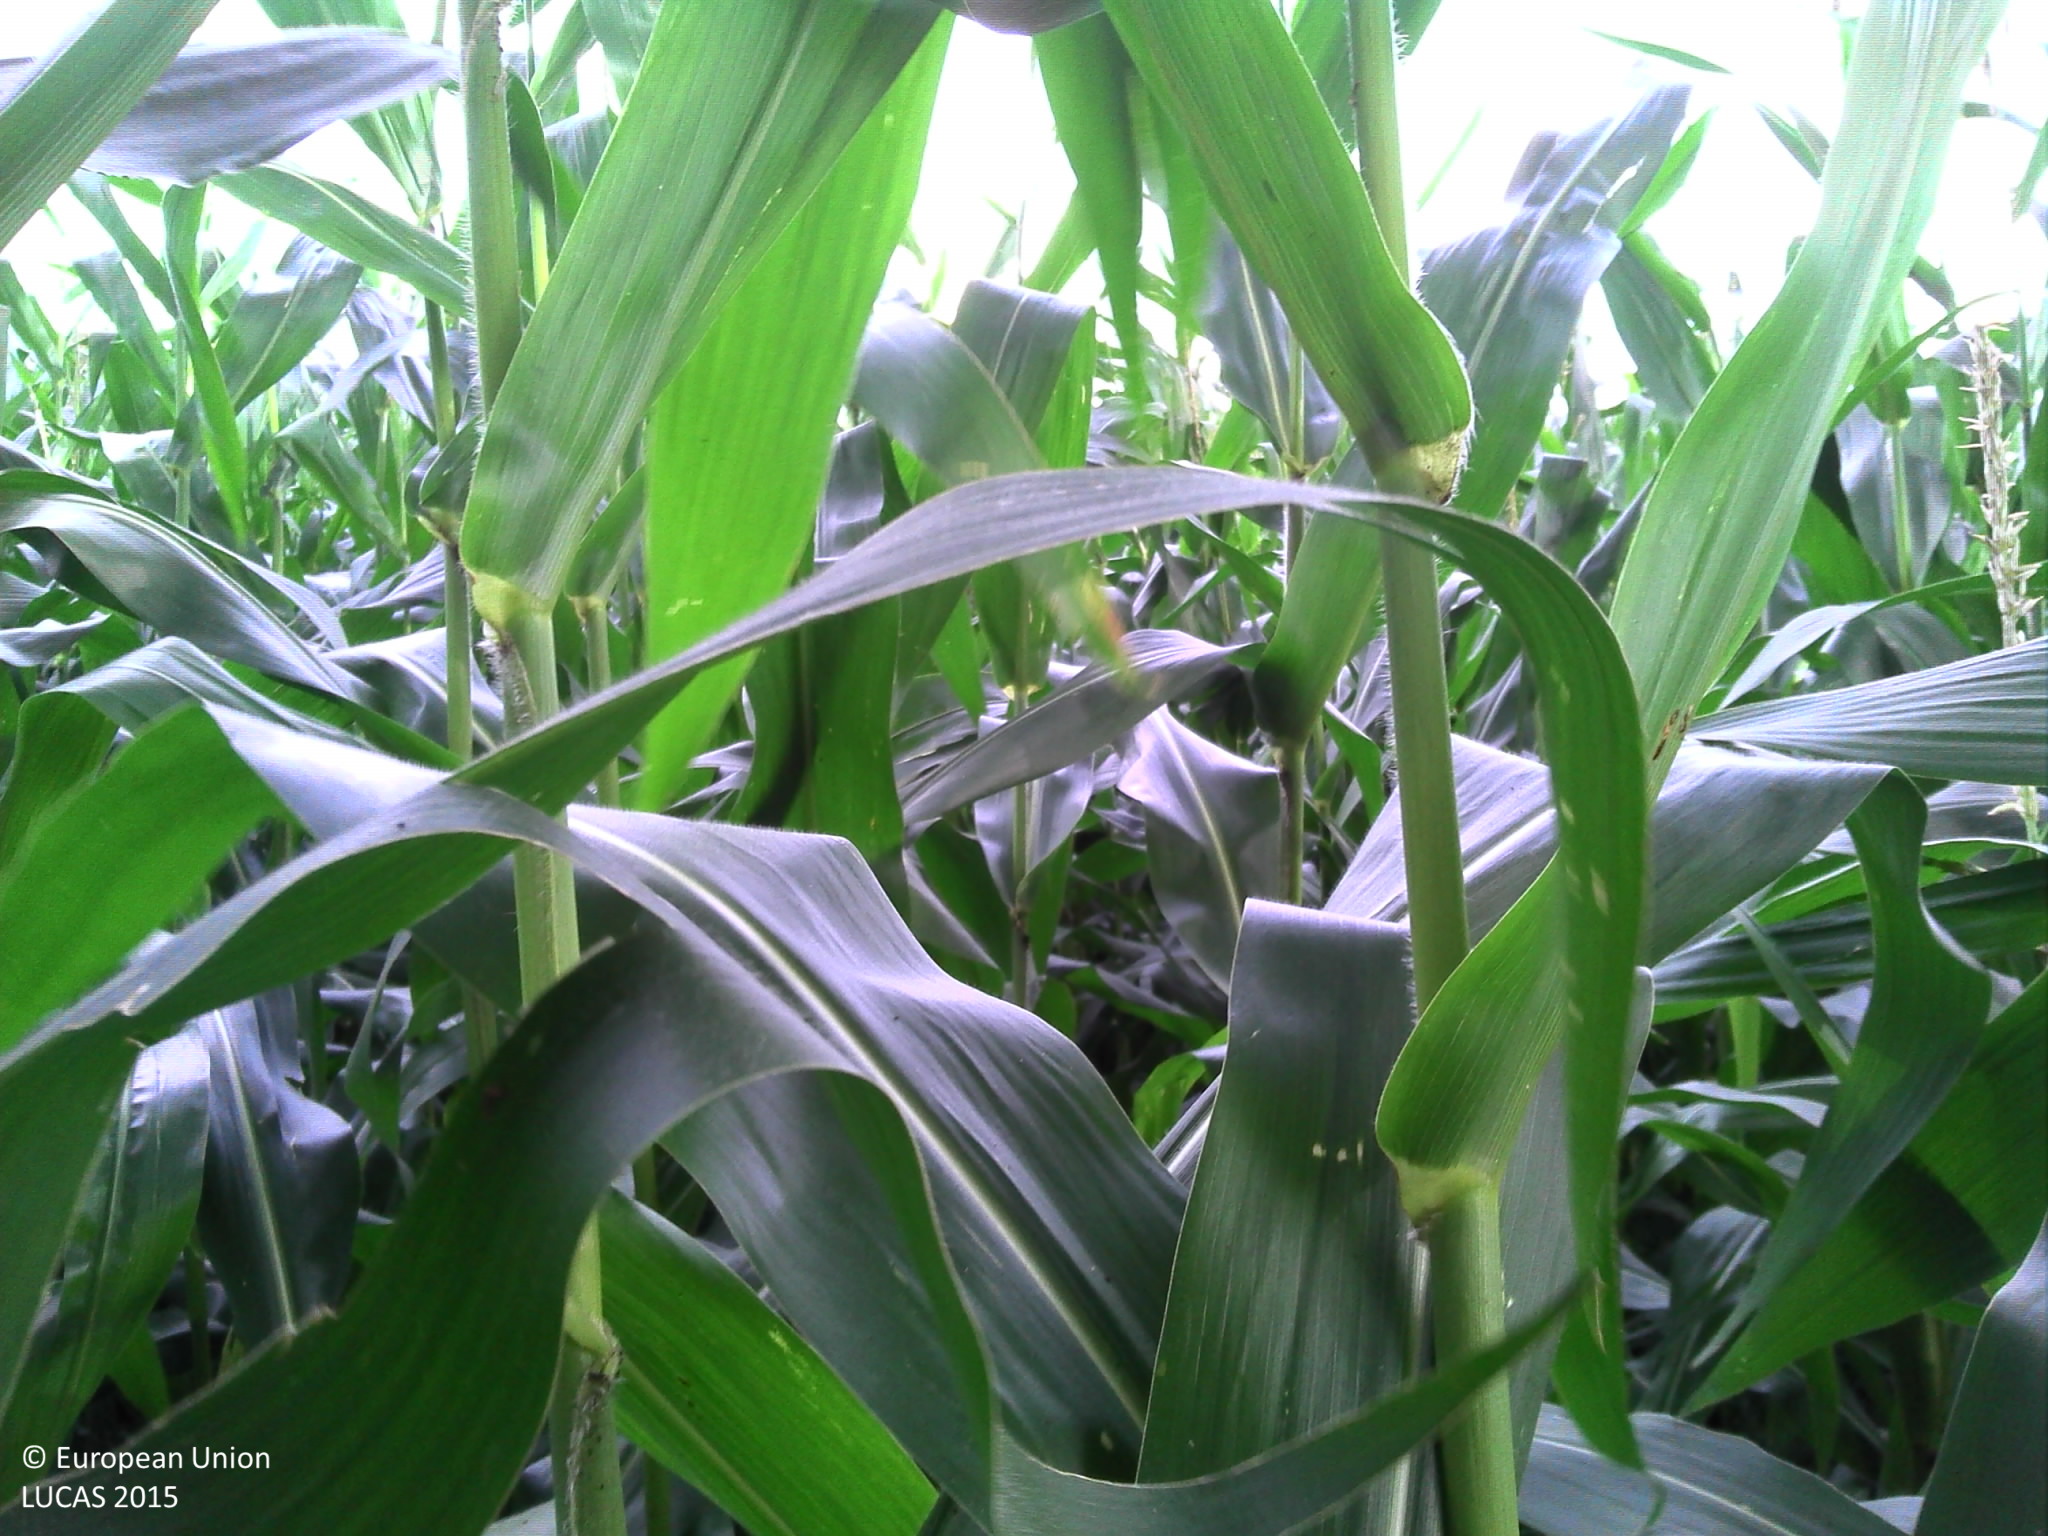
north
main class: Cropland
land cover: Maize
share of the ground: > 75 %
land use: Agriculture (excluding fallow land and kitchen gardens)
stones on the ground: < 10 %
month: September
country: BE
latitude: 51.4067
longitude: 4.5762
